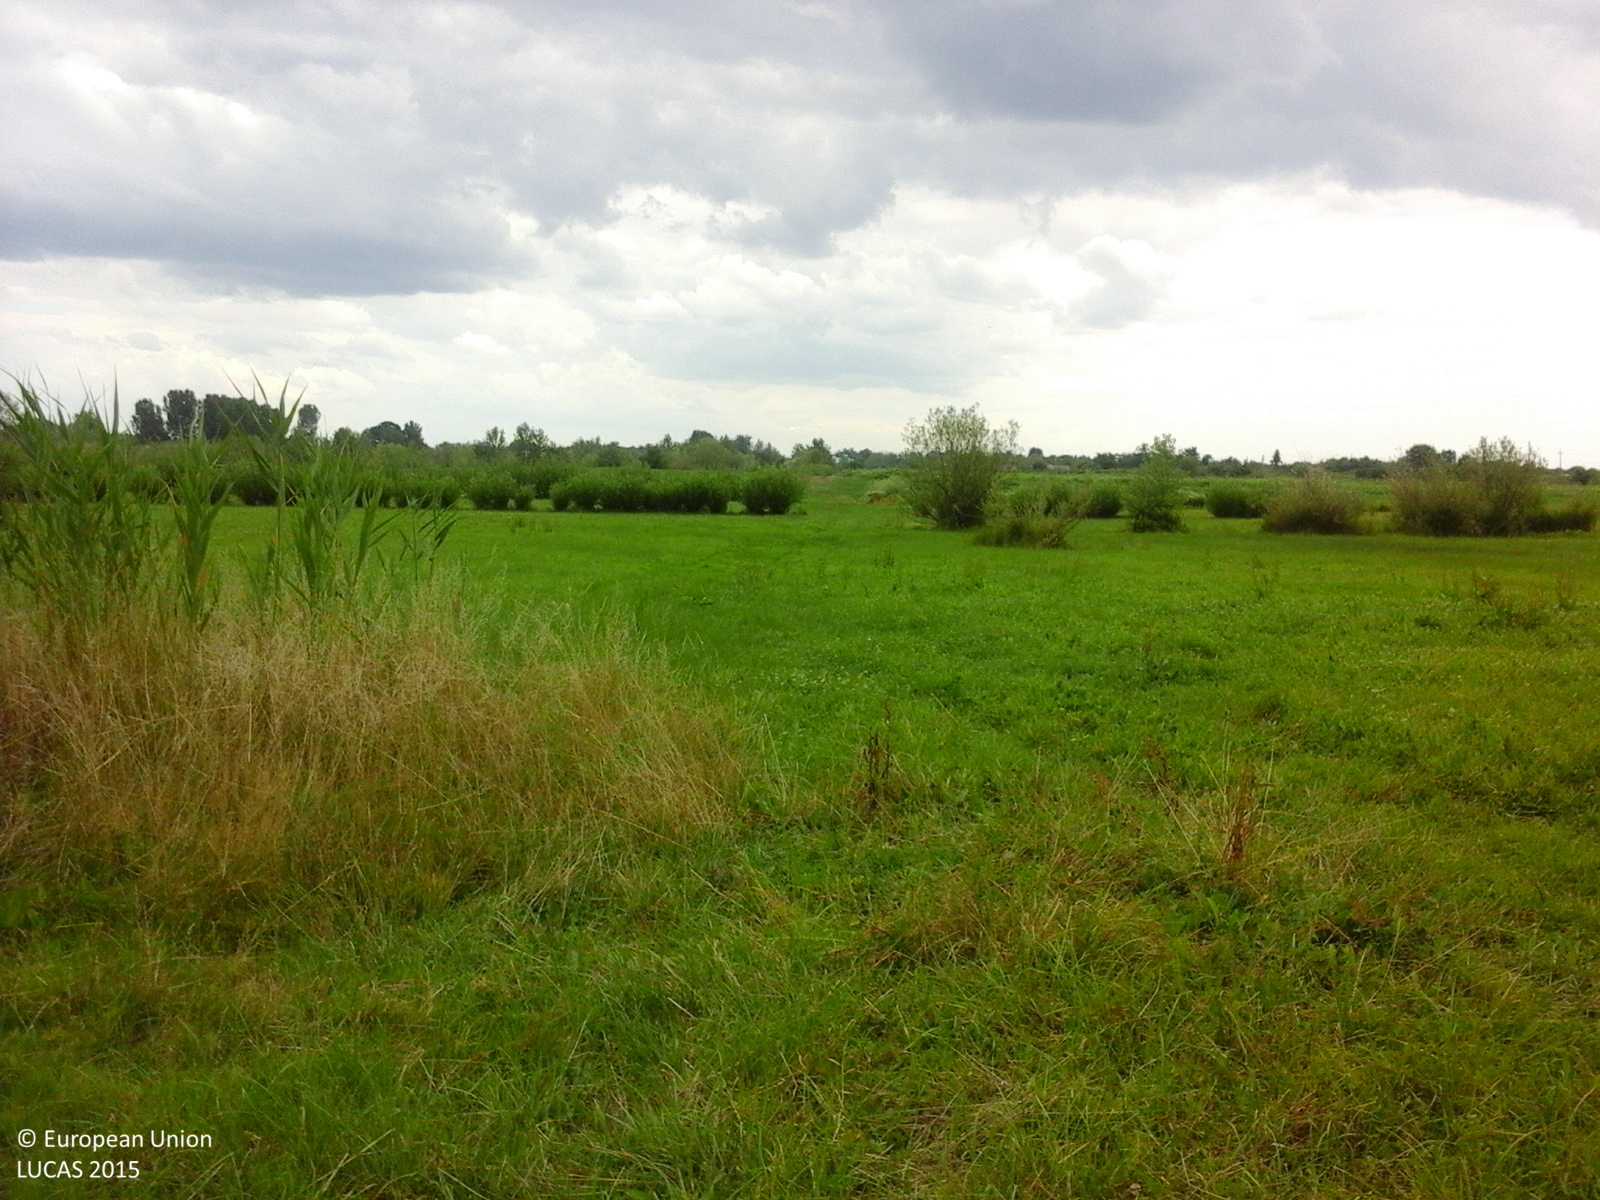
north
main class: Grassland
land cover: Grassland without tree/shrub cover
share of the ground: > 75 %
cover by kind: herbaceous plants 100 %
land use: Agriculture (excluding fallow land and kitchen gardens)
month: July
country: RO
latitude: 44.0143
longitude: 24.8041
